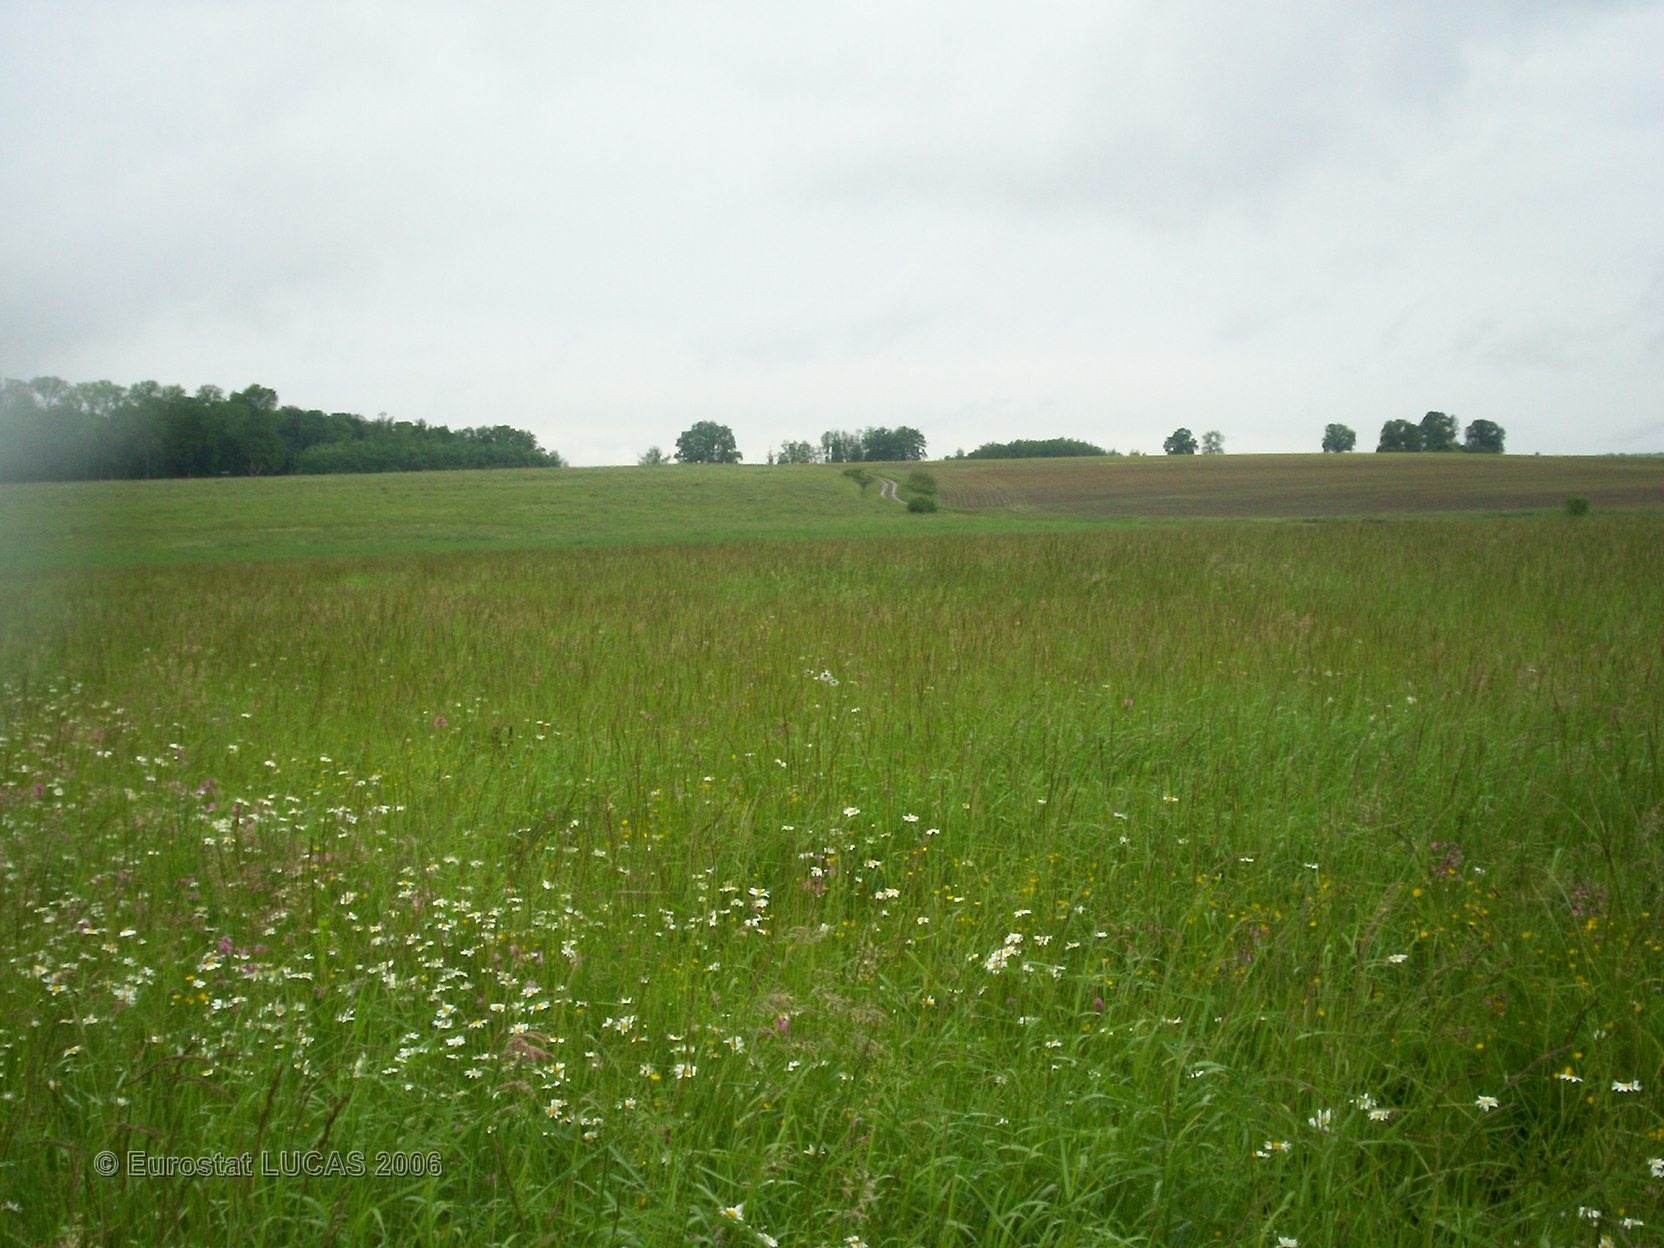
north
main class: Grassland
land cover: Grassland without tree/shrub cover
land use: Agriculture (excluding fallow land and kitchen gardens)
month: May
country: FR
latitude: 48.5378
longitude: 6.8178
